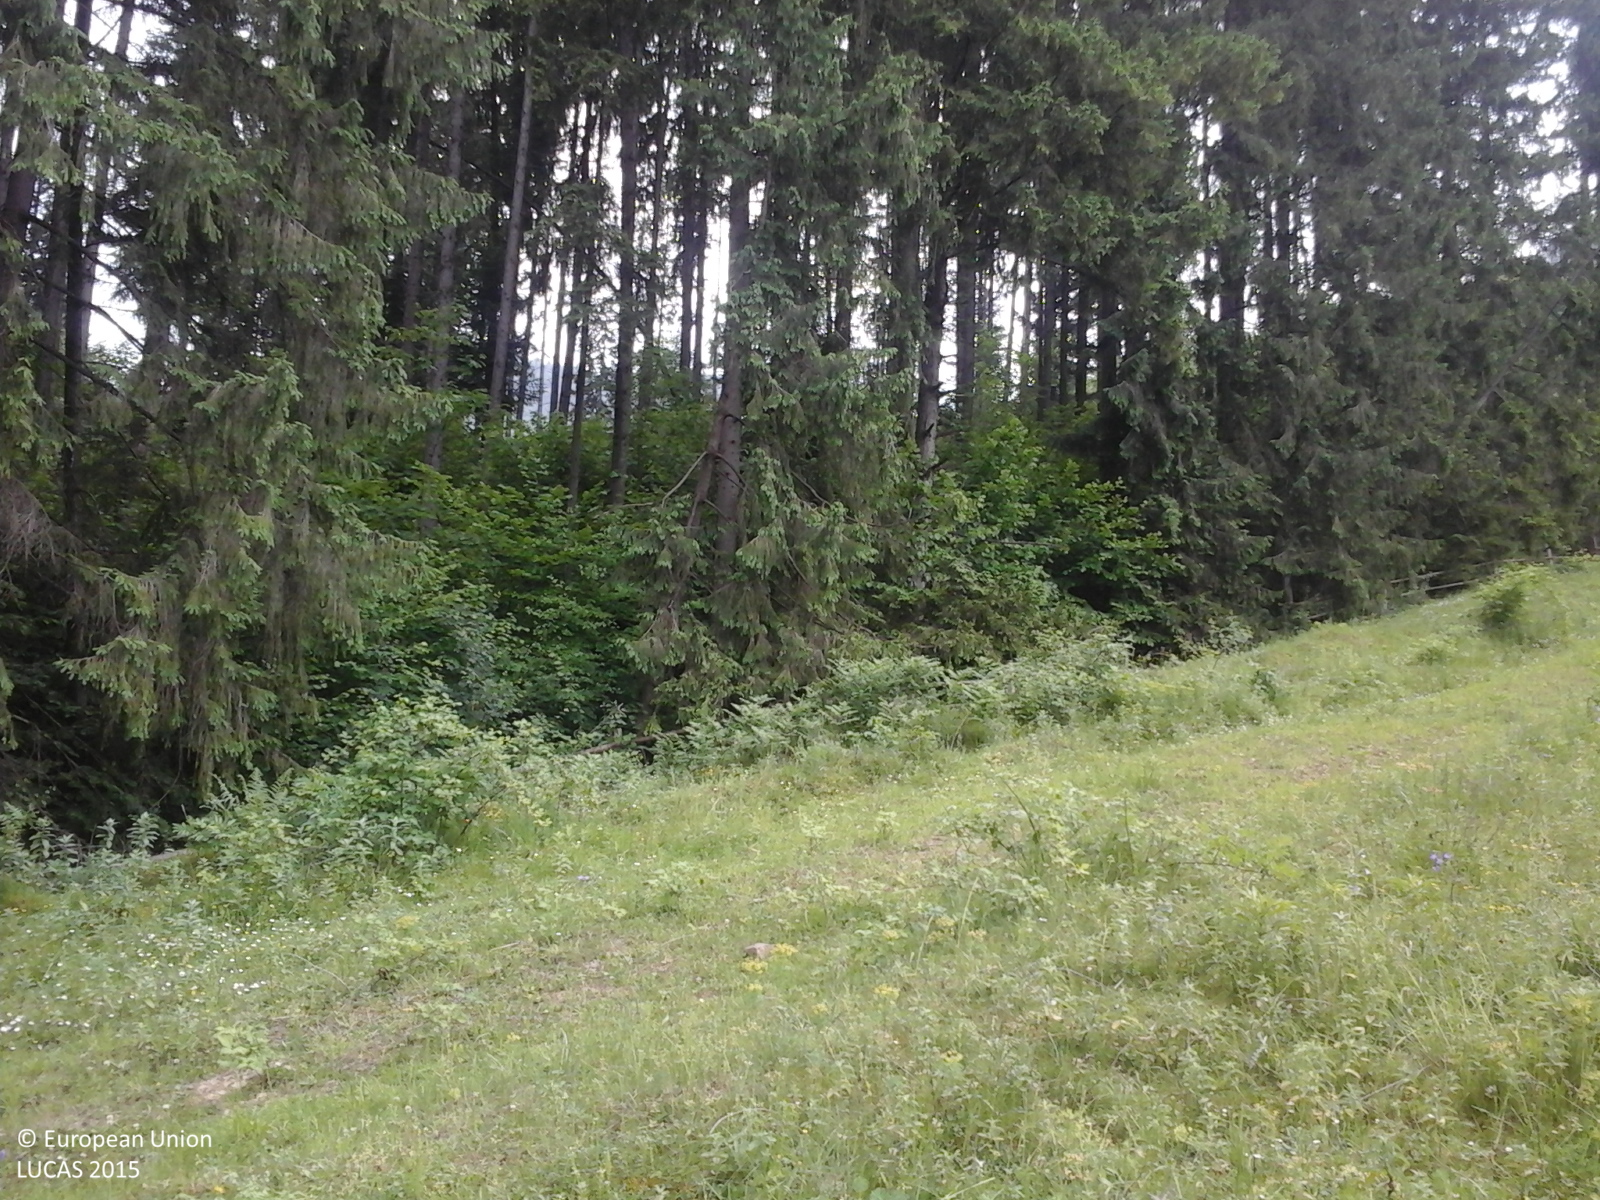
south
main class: Grassland
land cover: Grassland with sparse tree/shrub cover
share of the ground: > 75 %
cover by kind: herbaceous plants 85 %, shrubs 10 %, broadleaved forest trees 5 %
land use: Agriculture (excluding fallow land and kitchen gardens)
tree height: > 5 m
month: June
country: RO
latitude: 46.9010
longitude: 26.1023
